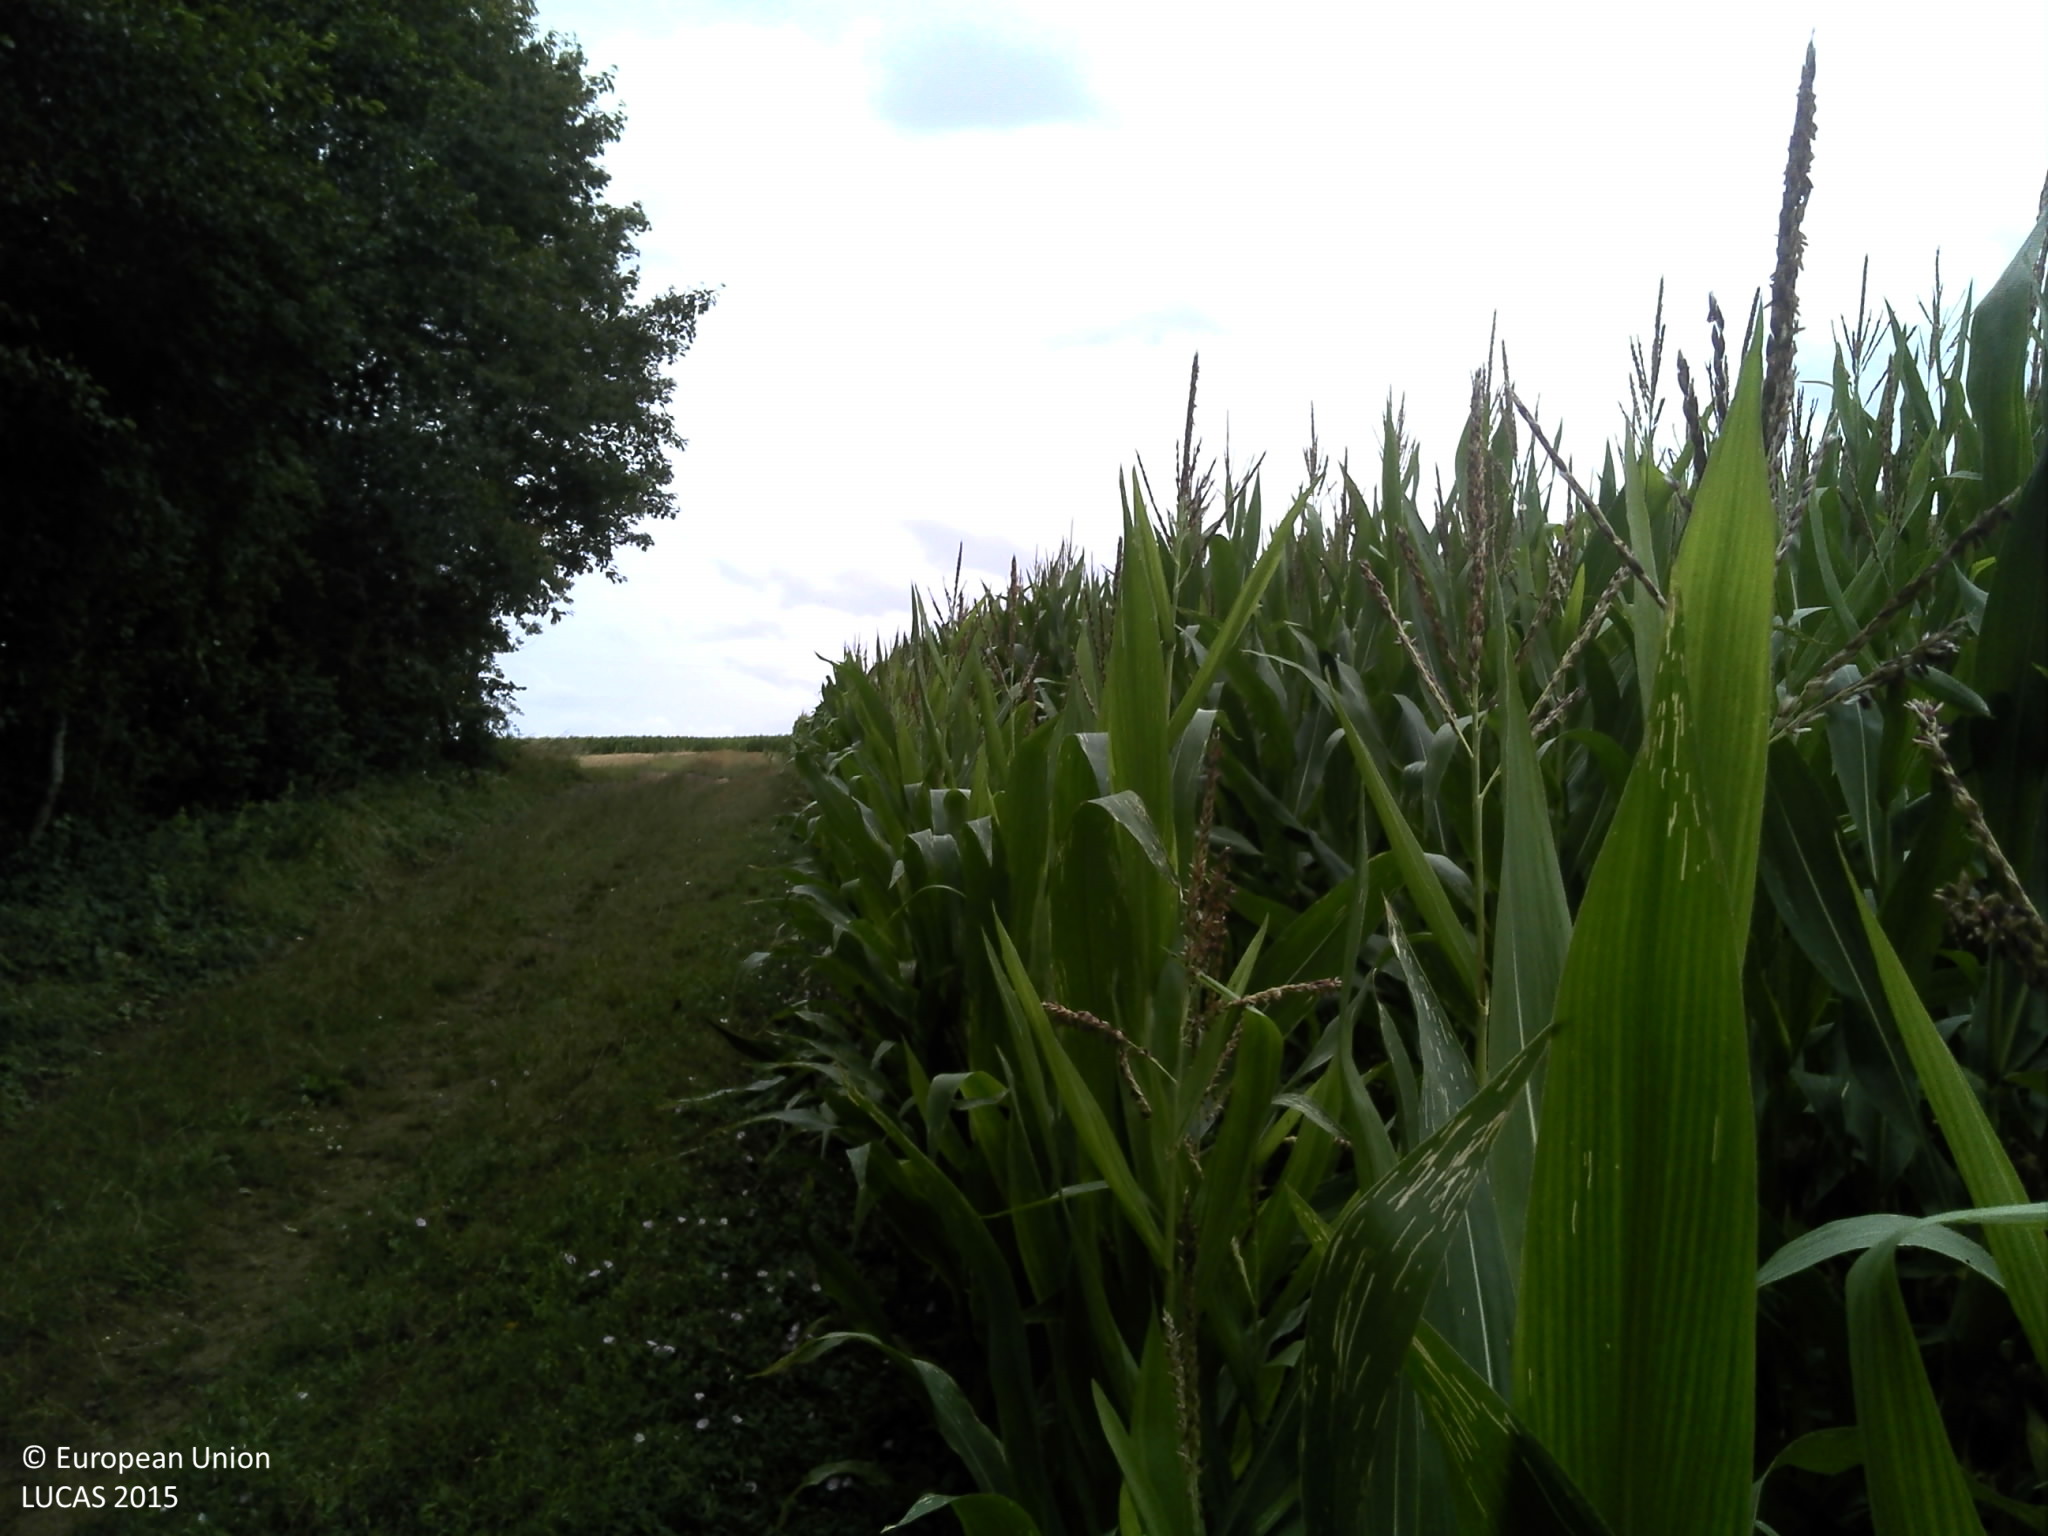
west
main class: Cropland
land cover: Maize
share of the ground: > 75 %
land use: Agriculture (excluding fallow land and kitchen gardens)
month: July
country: FR
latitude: 49.5830
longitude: 4.1444
